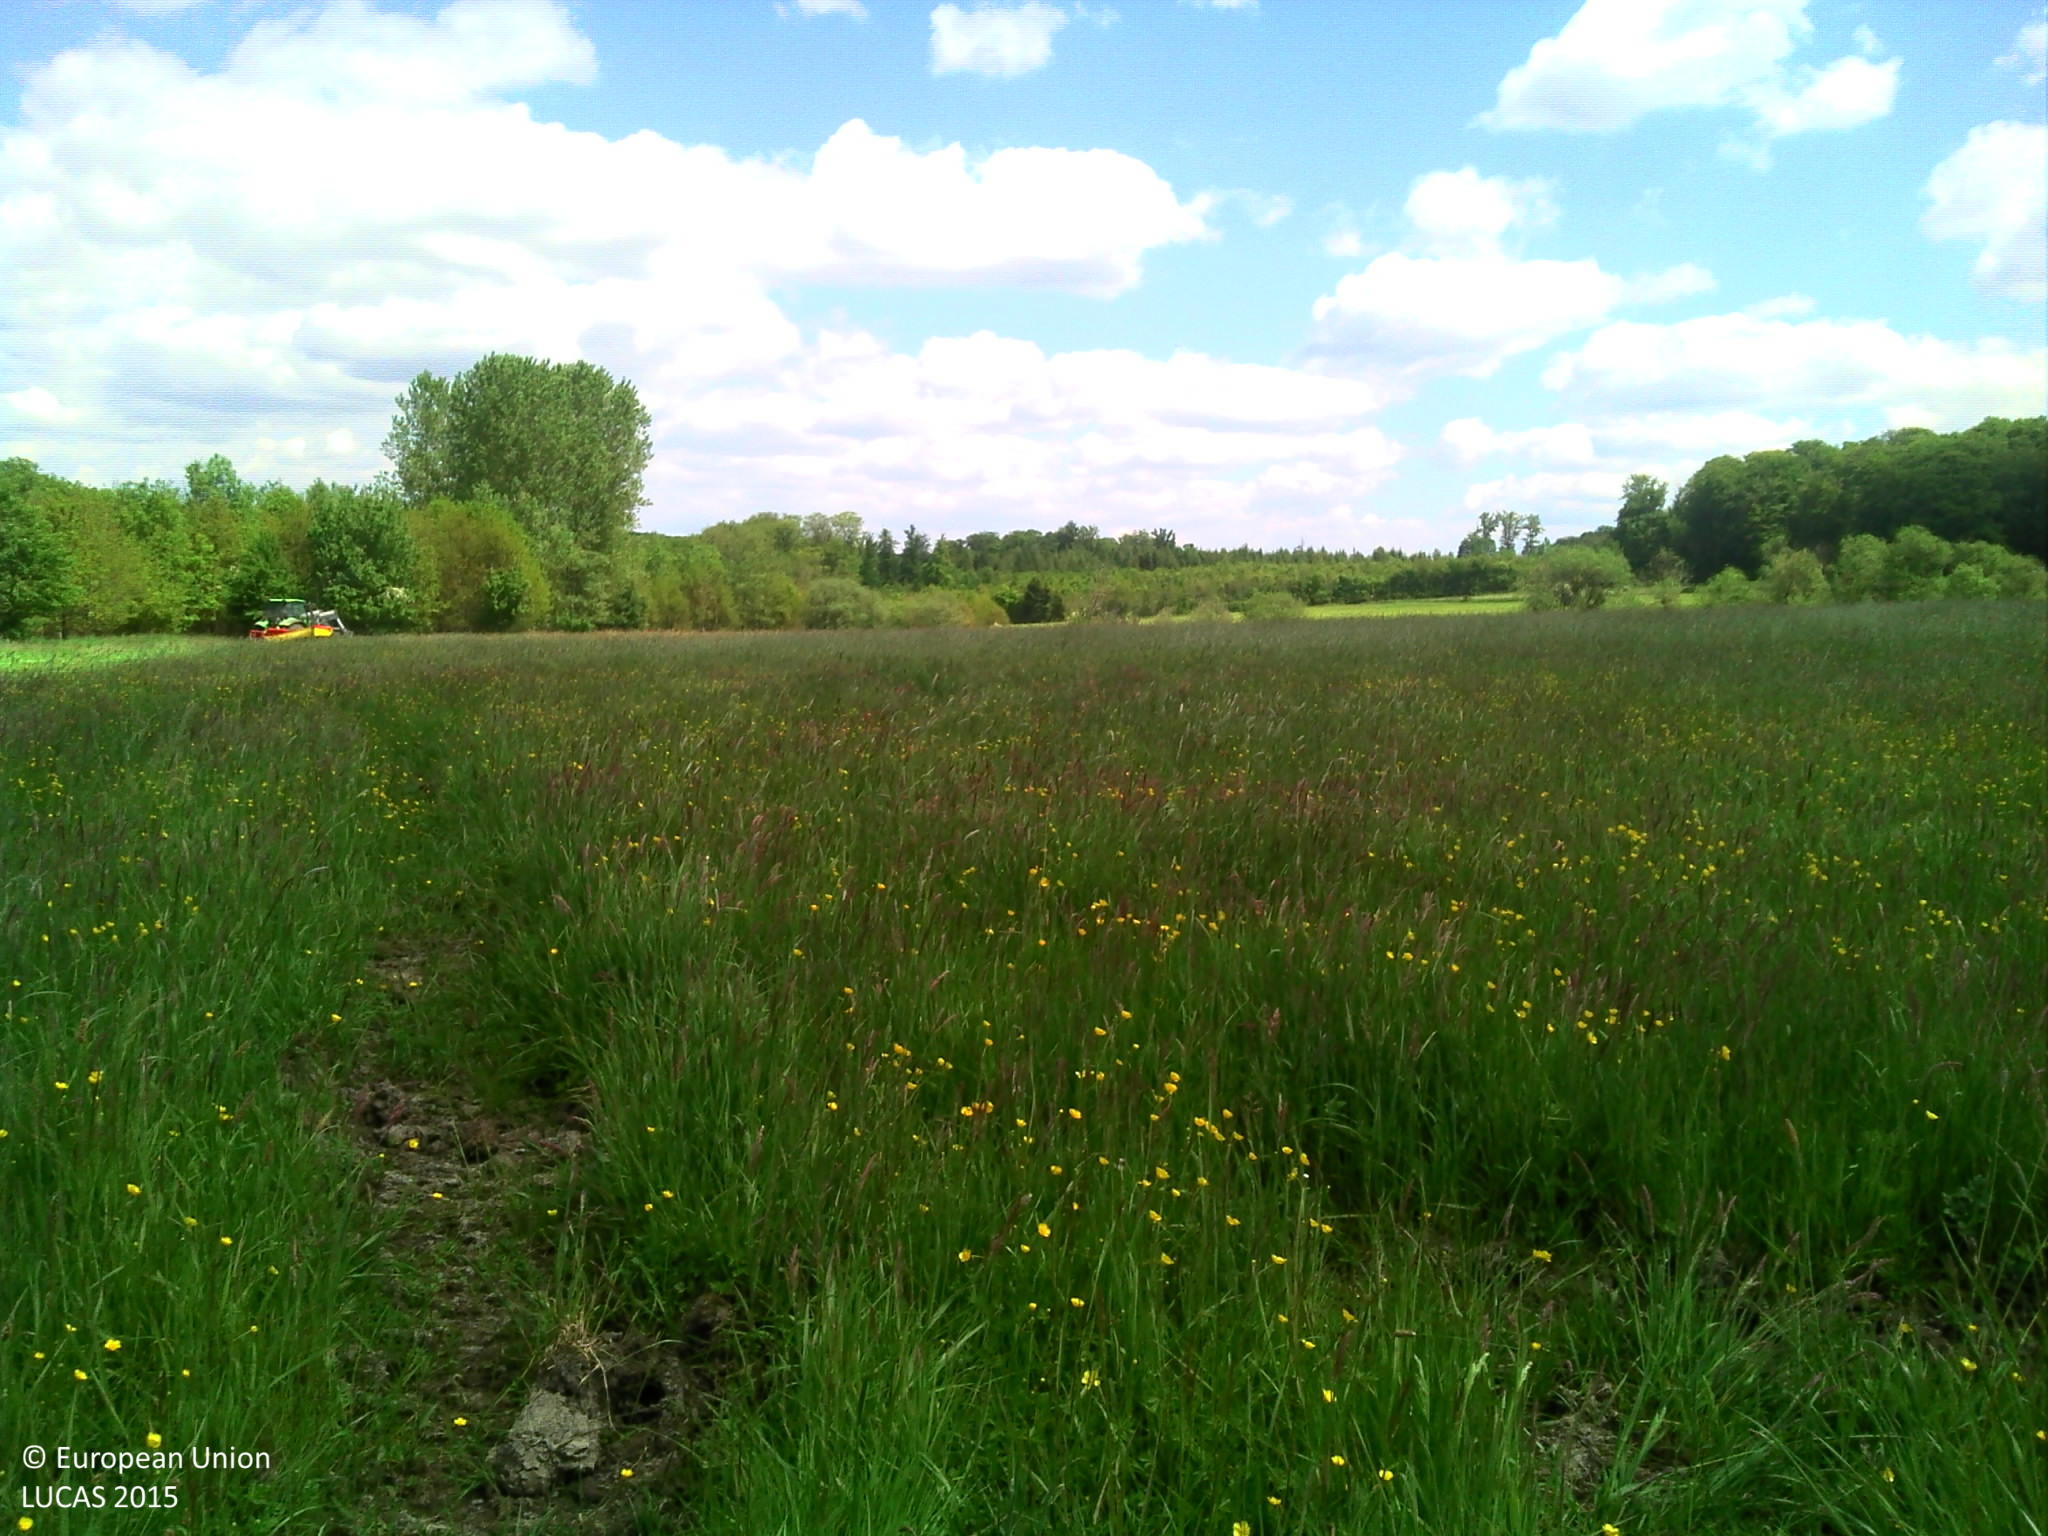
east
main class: Grassland
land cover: Grassland without tree/shrub cover
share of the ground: > 75 %
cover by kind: herbaceous plants 100 %
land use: Agriculture (excluding fallow land and kitchen gardens)
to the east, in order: Grassland without tree/shrub cover; Spontaneously vegetated surfaces; Ditches and canals; Lines of trees; Spontaneously vegetated surfaces
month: May
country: LU
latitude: 49.7101
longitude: 6.2969
